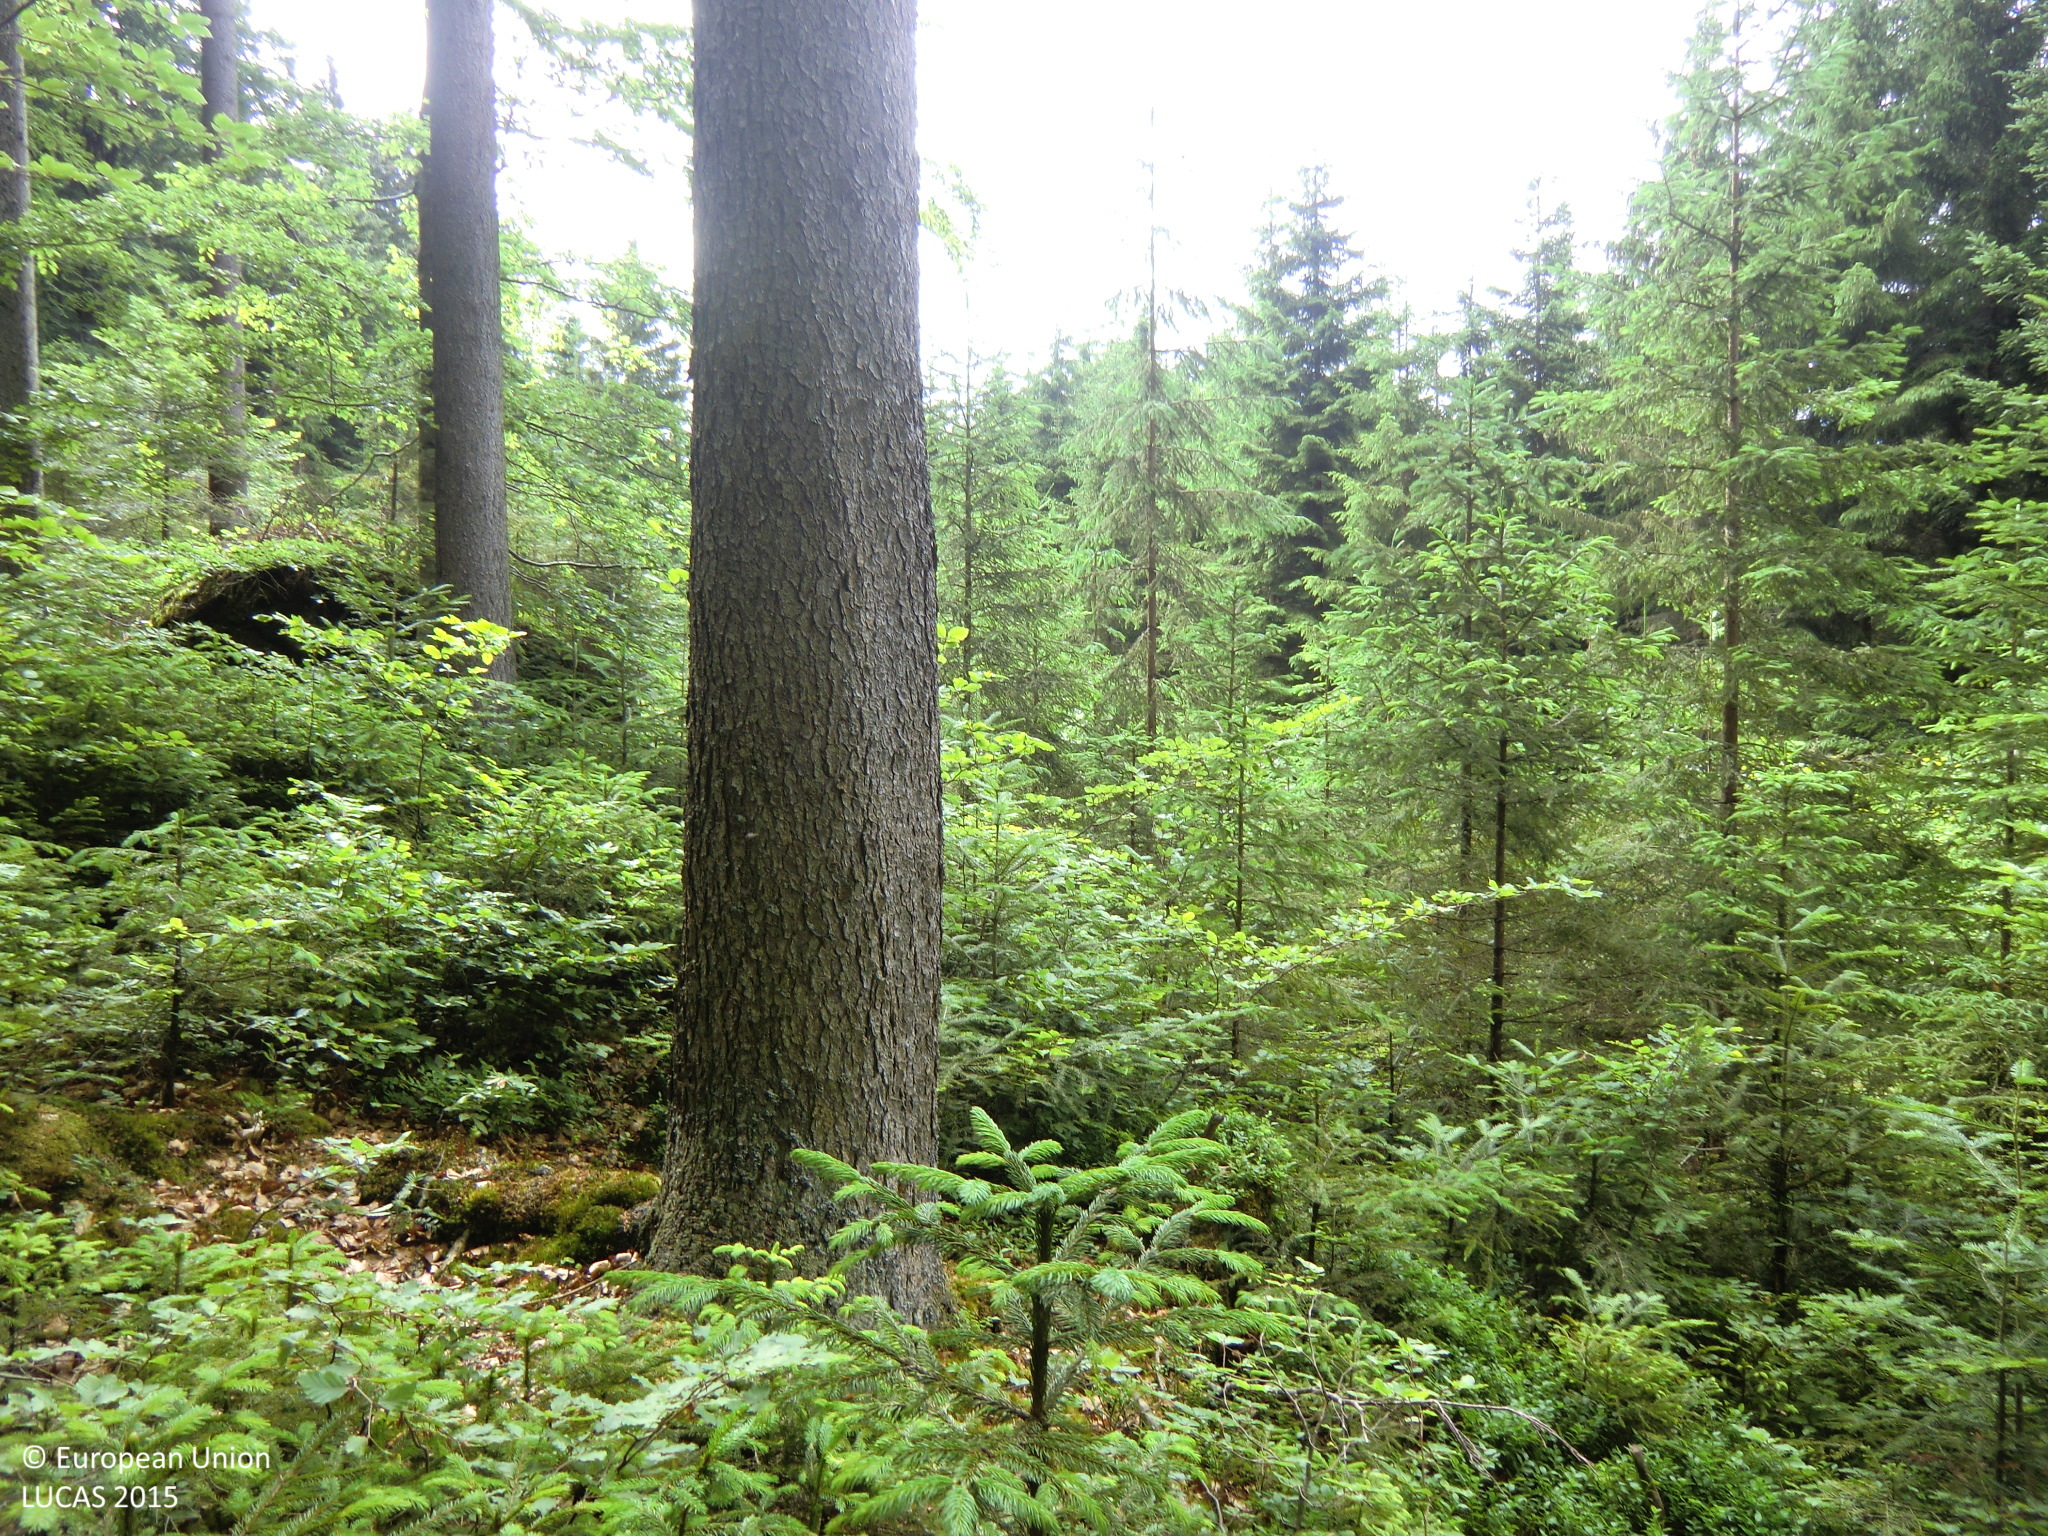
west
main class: Woodland
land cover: Spruce dominated mixed woodland
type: hemiboreal forest and nemoral coniferous forest and mixed broadleaved-coniferous forest
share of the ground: > 75 %
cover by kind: coniferous forest trees 45 %, broadleaved forest trees 45 %, herbaceous plants 5 %, unconsolidated bare surface 5 %
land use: Forestry
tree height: > 5 m
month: June
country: AT
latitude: 48.4531
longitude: 14.9909
